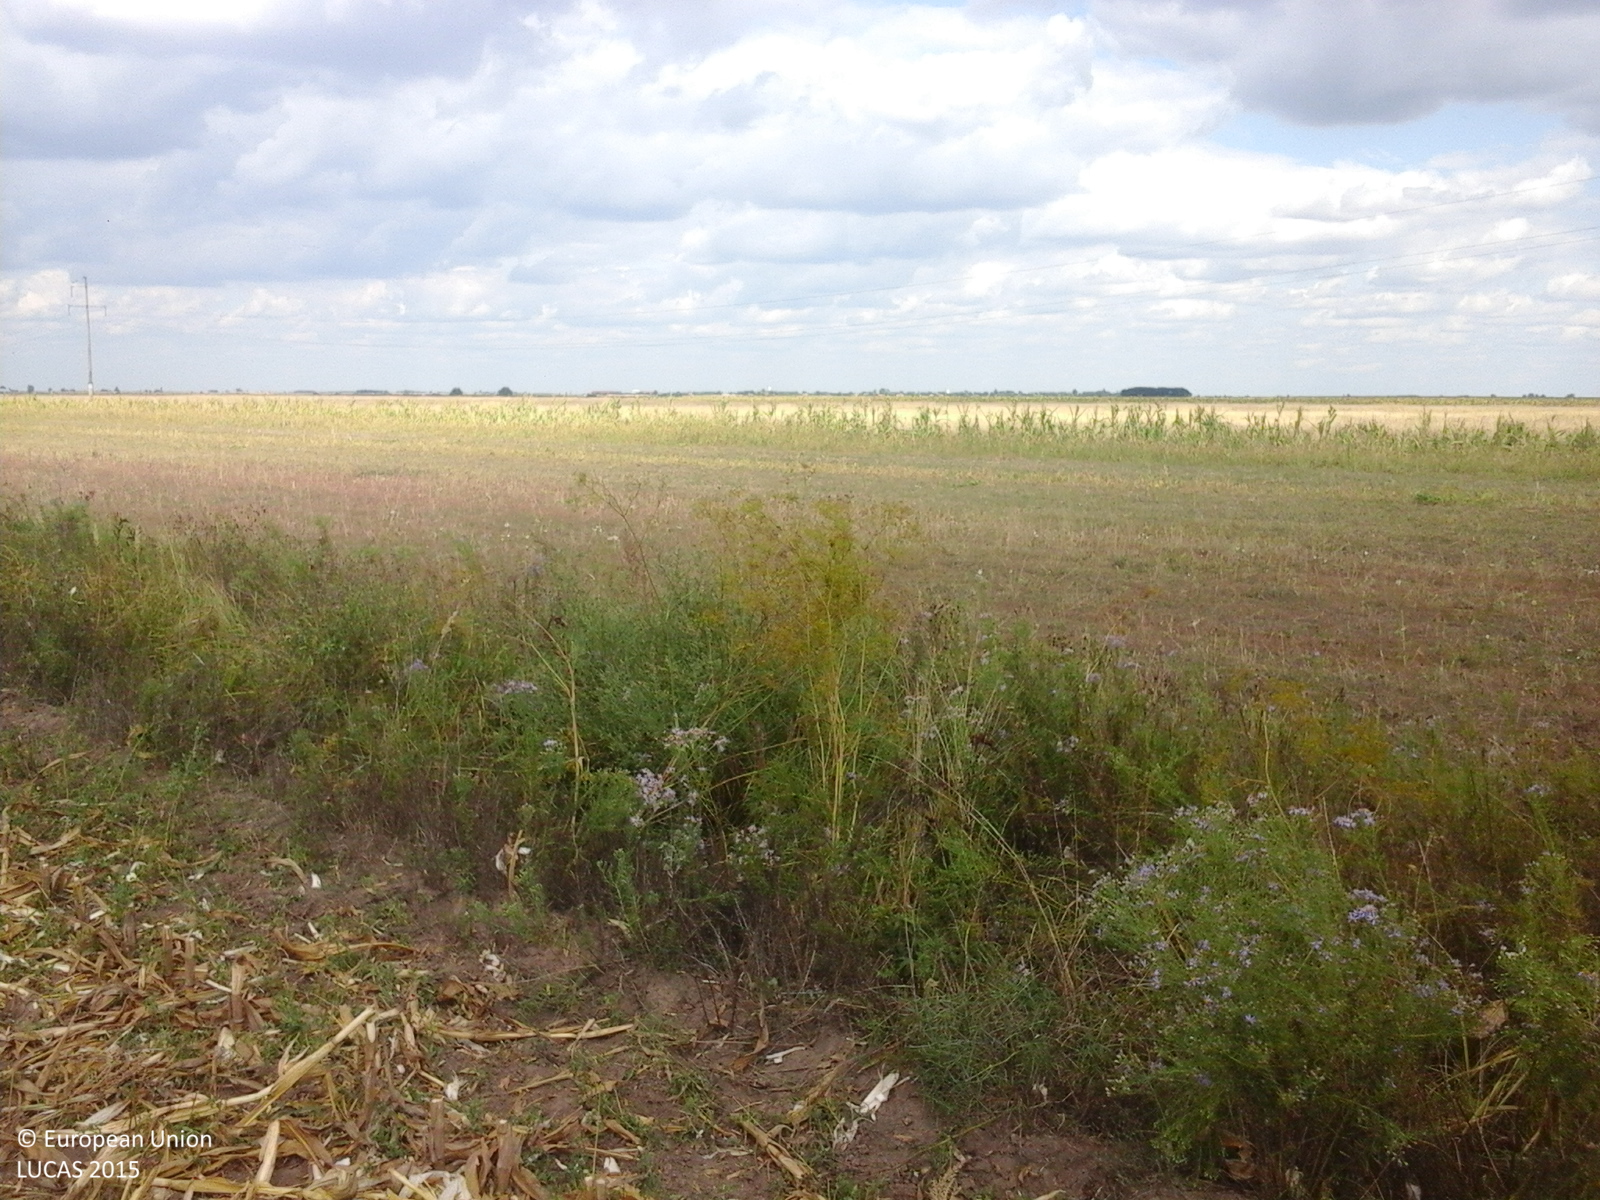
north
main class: Cropland
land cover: Maize
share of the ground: 10 - 25 %
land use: Agriculture (excluding fallow land and kitchen gardens)
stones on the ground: < 10 %
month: September
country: RO
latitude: 47.5499
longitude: 22.6160
